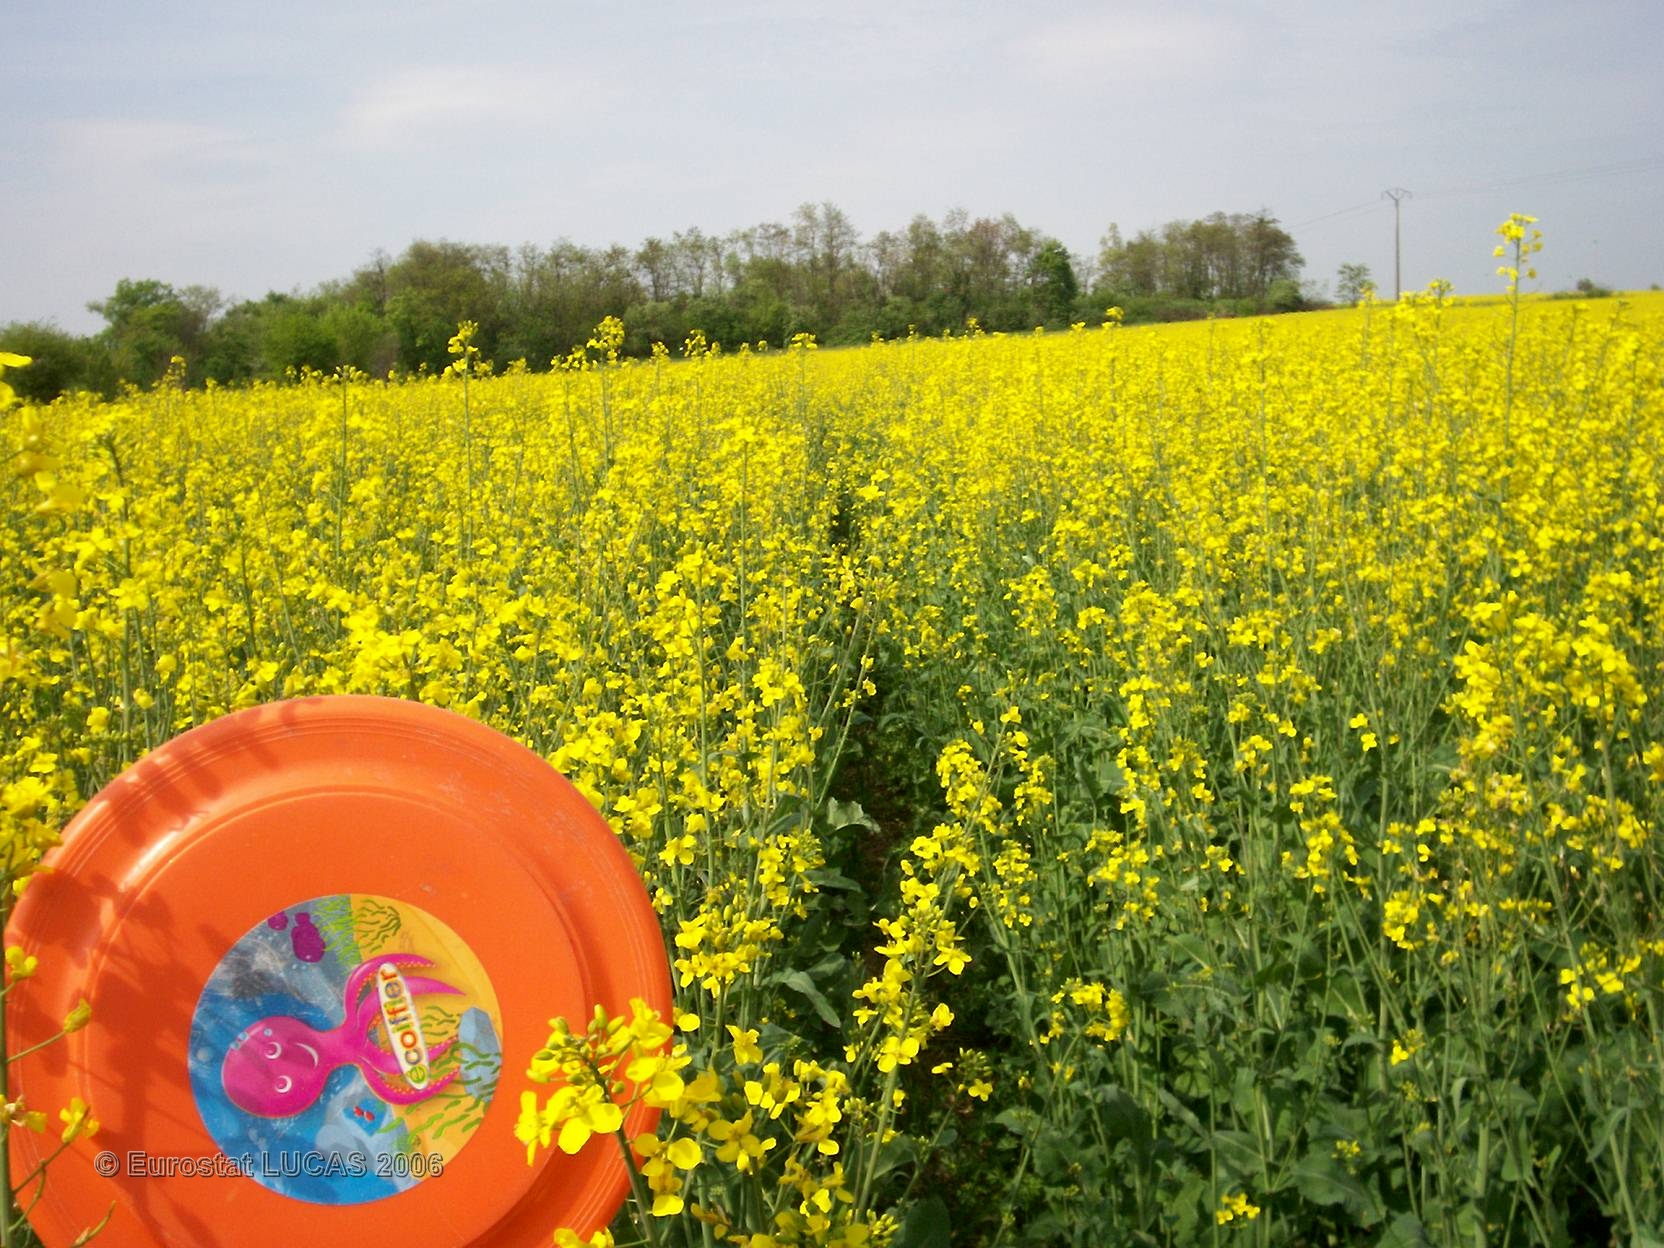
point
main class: Cropland
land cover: Rape and turnip rape
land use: Agriculture (excluding fallow land and kitchen gardens)
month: May
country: FR
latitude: 46.0222
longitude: 4.7195
